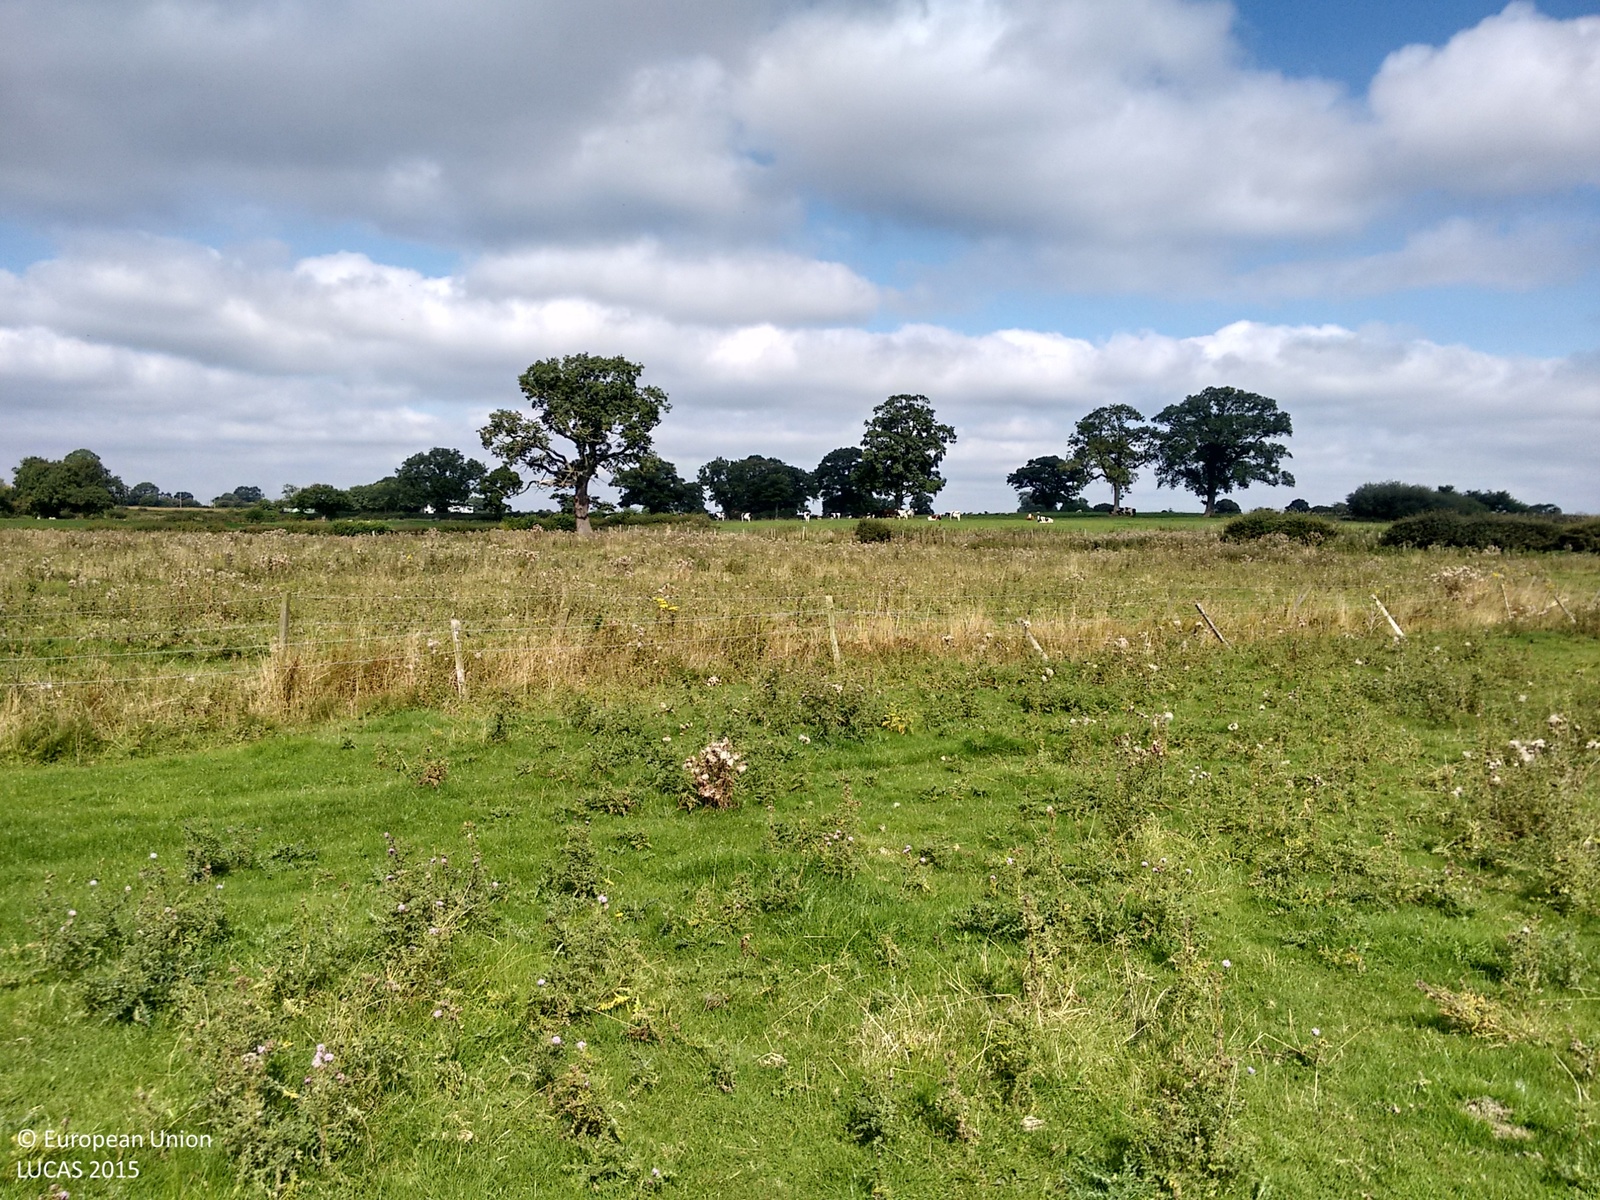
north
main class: Grassland
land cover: Grassland without tree/shrub cover
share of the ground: > 75 %
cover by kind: herbaceous plants 100 %
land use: Agriculture (excluding fallow land and kitchen gardens)
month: September
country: GB
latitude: 52.9333
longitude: -2.6703
